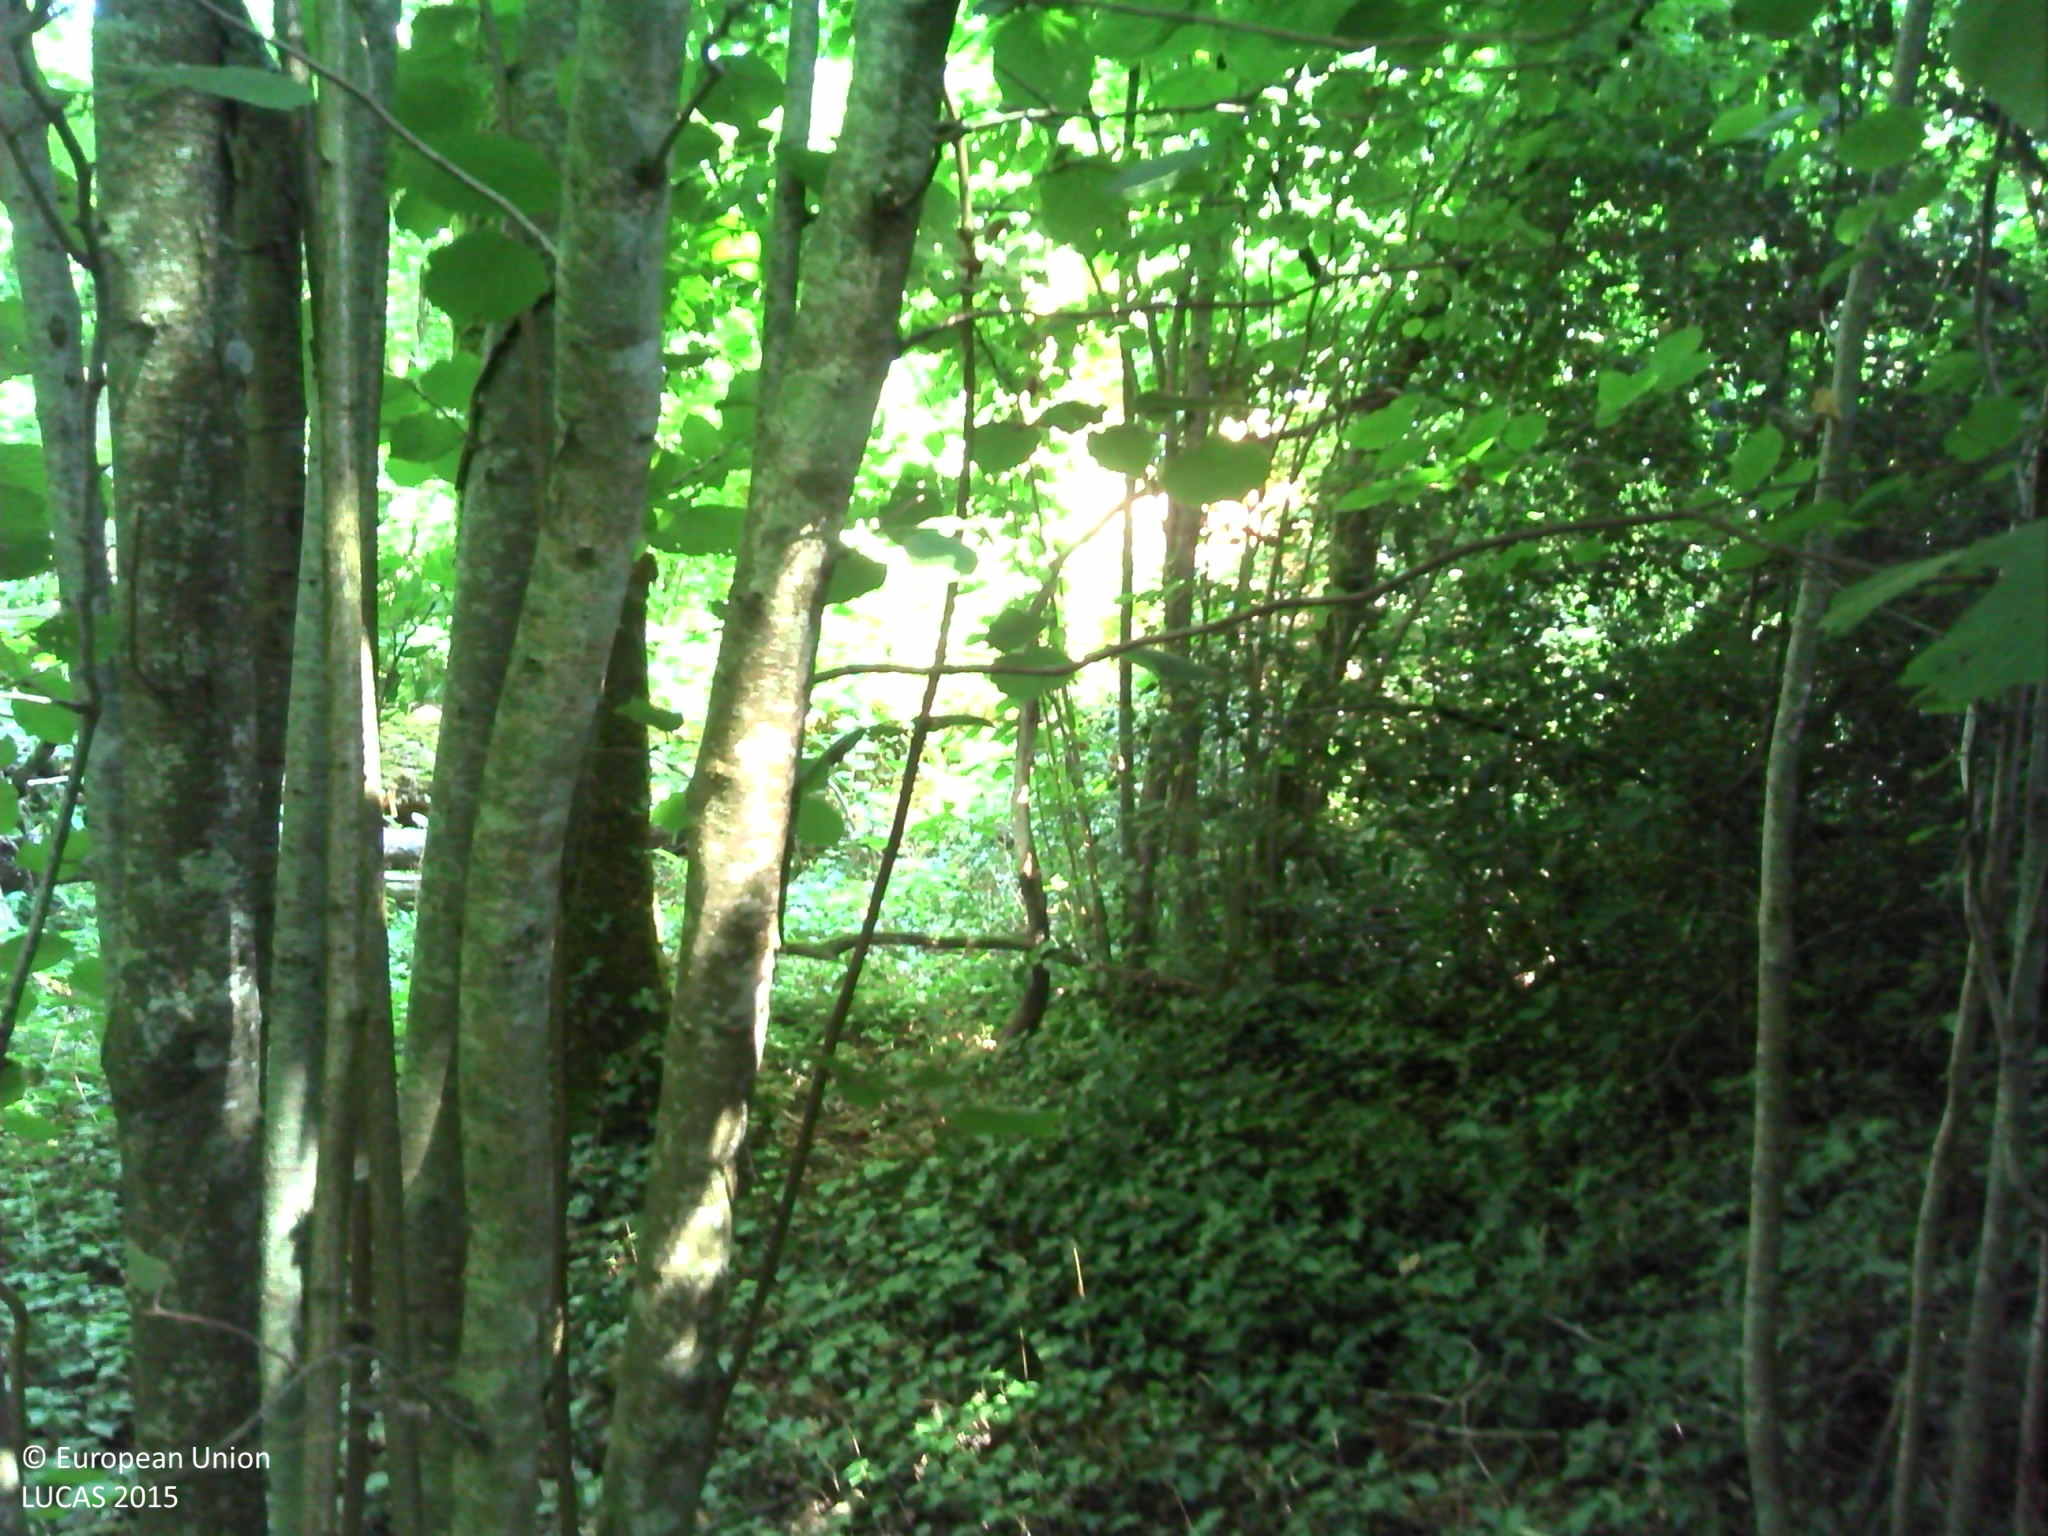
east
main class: Woodland
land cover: Broadleaved woodland
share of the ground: > 75 %
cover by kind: broadleaved forest trees 40 %, herbaceous plants 20 %, lichens and mosses 20 %, unconsolidated bare surface 20 %
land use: Forestry
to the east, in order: Broadleaved woodland; Fences; Grassland without tree/shrub cover; Broadleaved woodland; Fences; Grass margins; Ditches and canals; Grass margins; Paved roads, cycling and walking lanes; Grassland without tree/shrub cover; Spontaneously vegetated surfaces; Broadleaved woodland
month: July
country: FR
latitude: 45.6446
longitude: 0.9957
